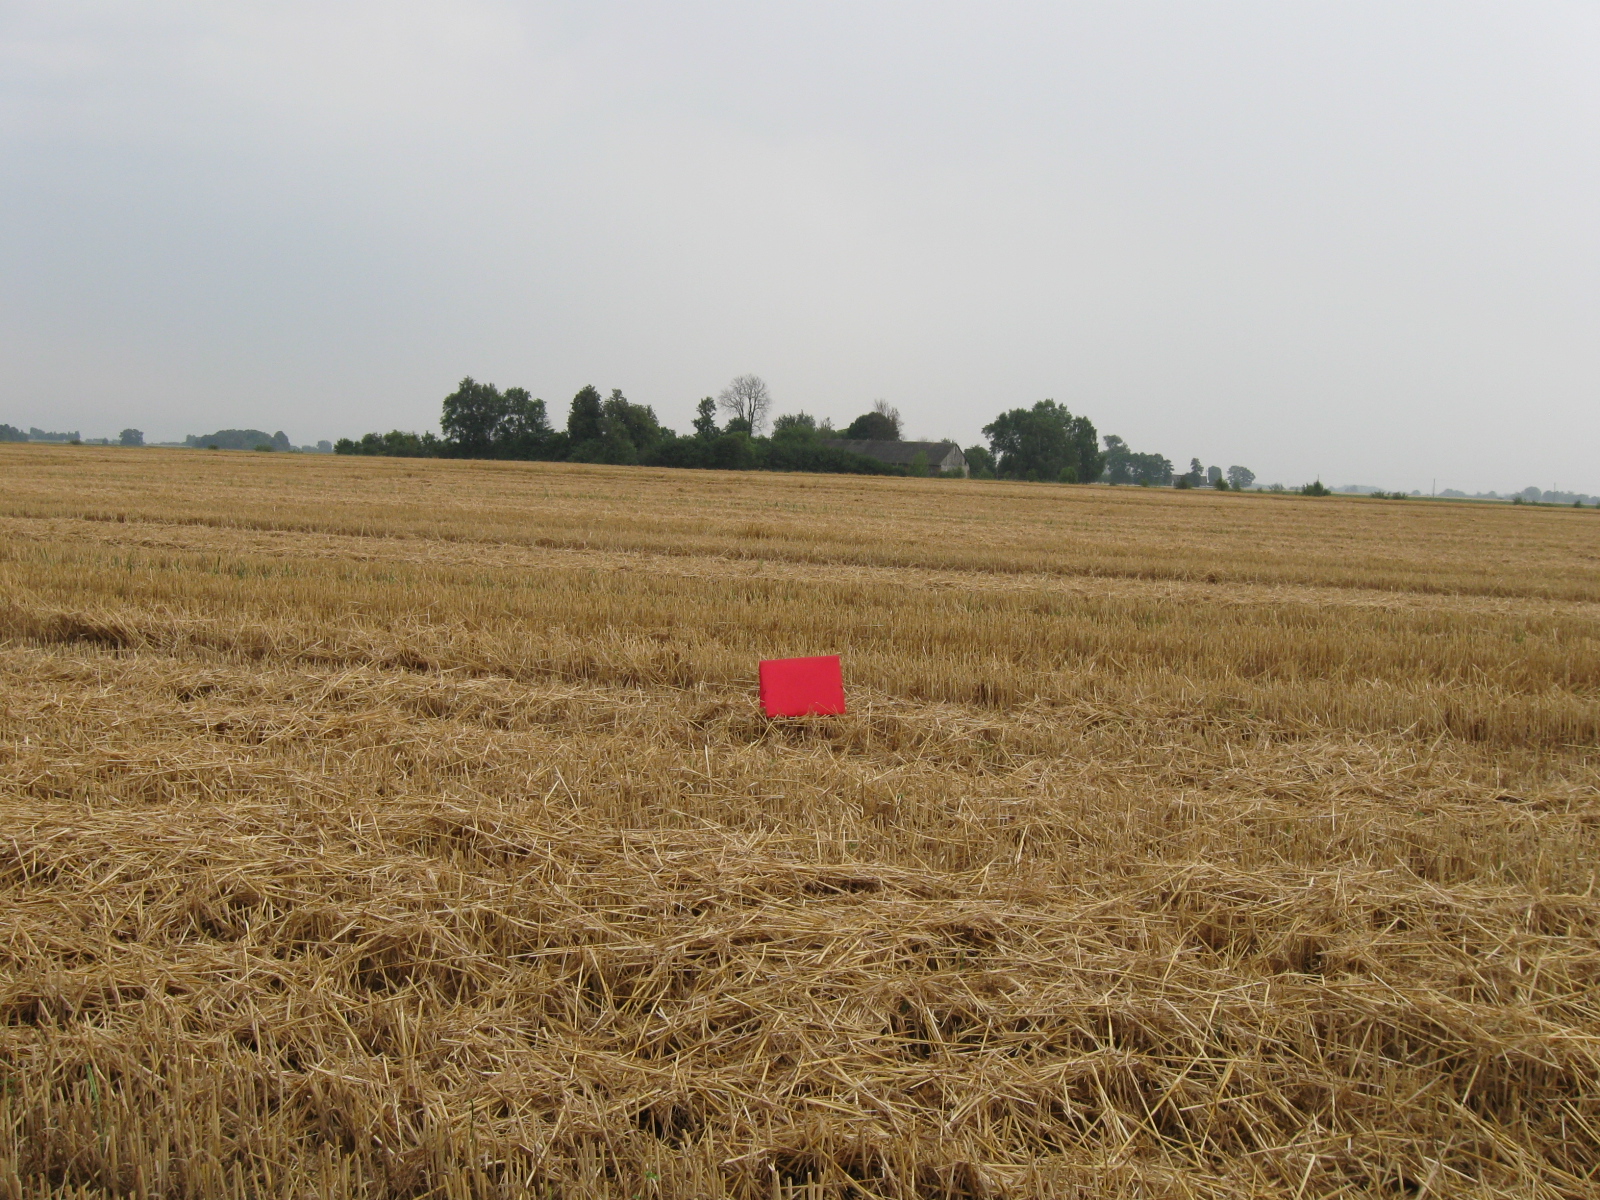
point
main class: Cropland
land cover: Common wheat
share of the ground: > 75 %
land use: Agriculture (excluding fallow land and kitchen gardens)
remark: Harvested field
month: August
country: LT
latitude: 54.6741
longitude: 23.4321
